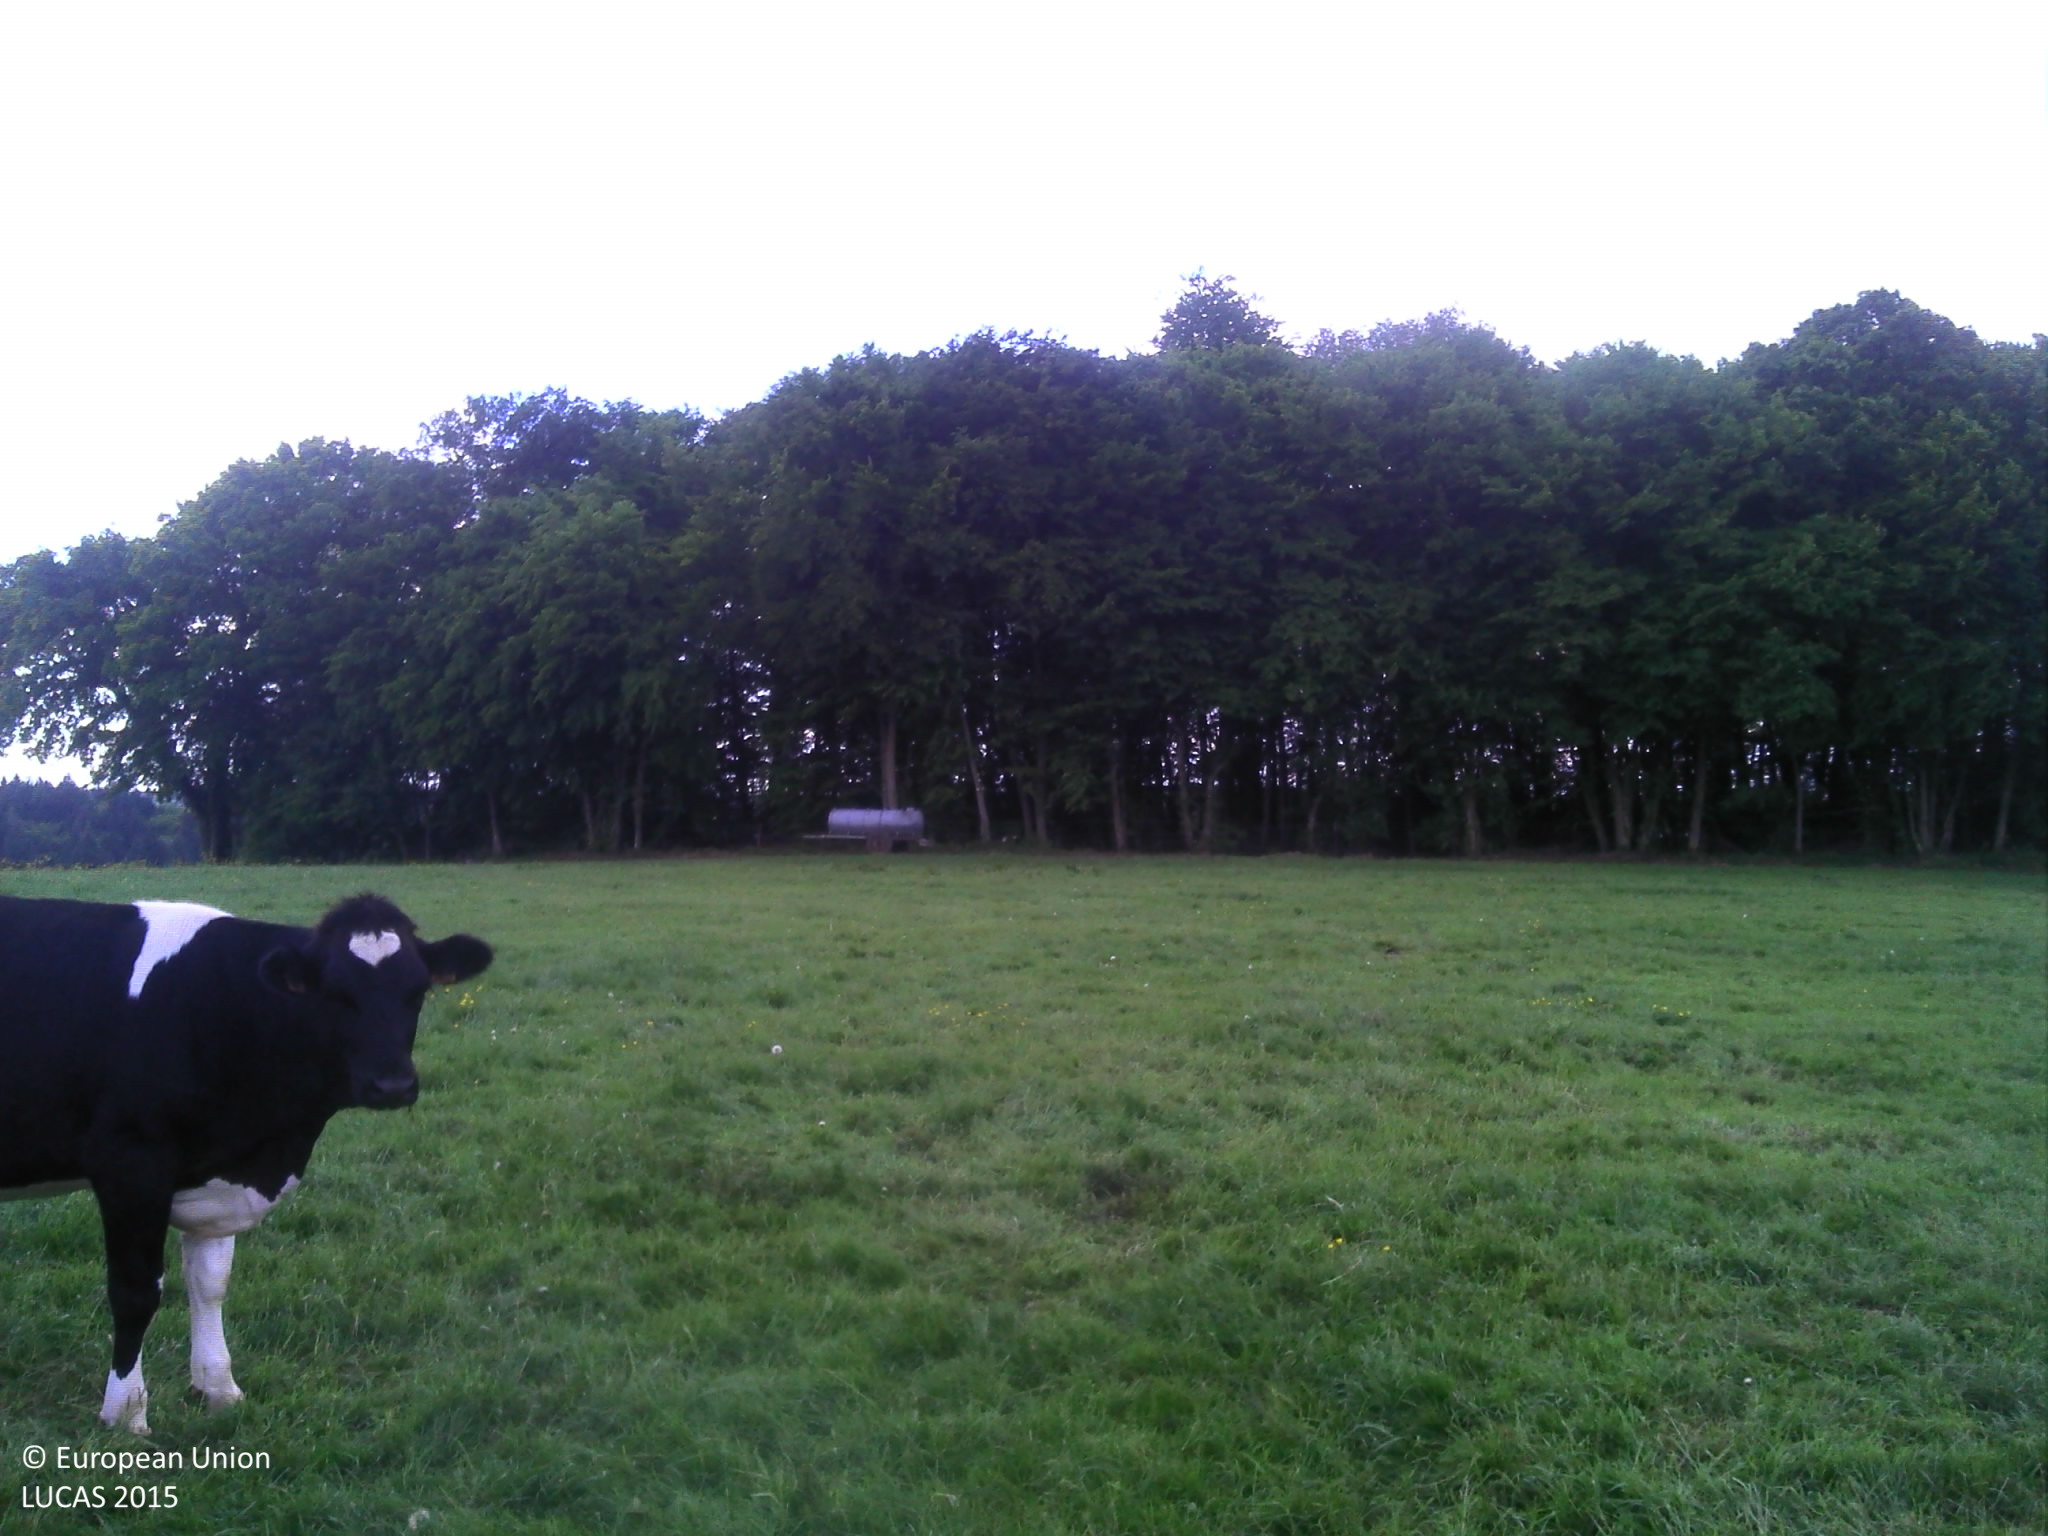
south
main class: Grassland
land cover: Grassland without tree/shrub cover
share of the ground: > 75 %
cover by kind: herbaceous plants 100 %
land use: Agriculture (excluding fallow land and kitchen gardens)
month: May
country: LU
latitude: 49.8026
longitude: 6.3733
